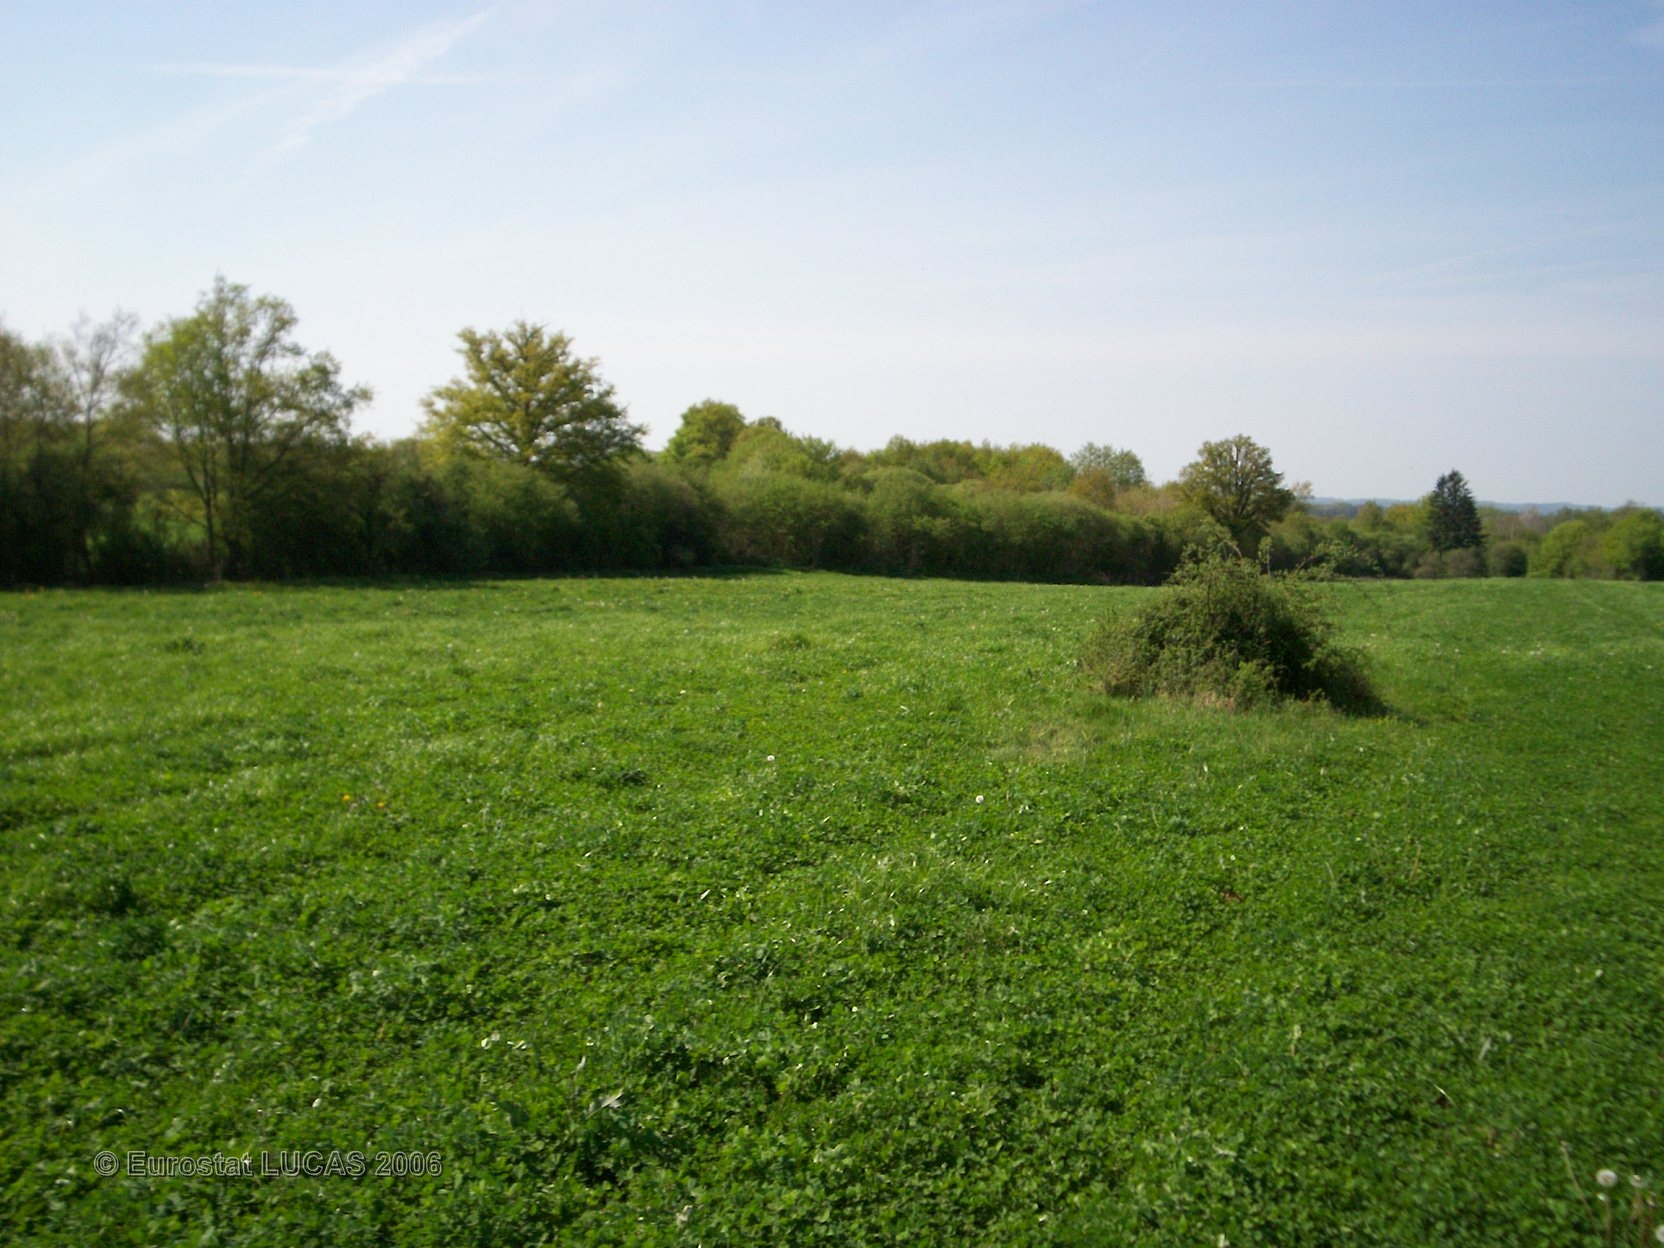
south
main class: Cropland
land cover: Clovers
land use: Agriculture (excluding fallow land and kitchen gardens)
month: May
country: FR
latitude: 46.3490
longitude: 1.6357
